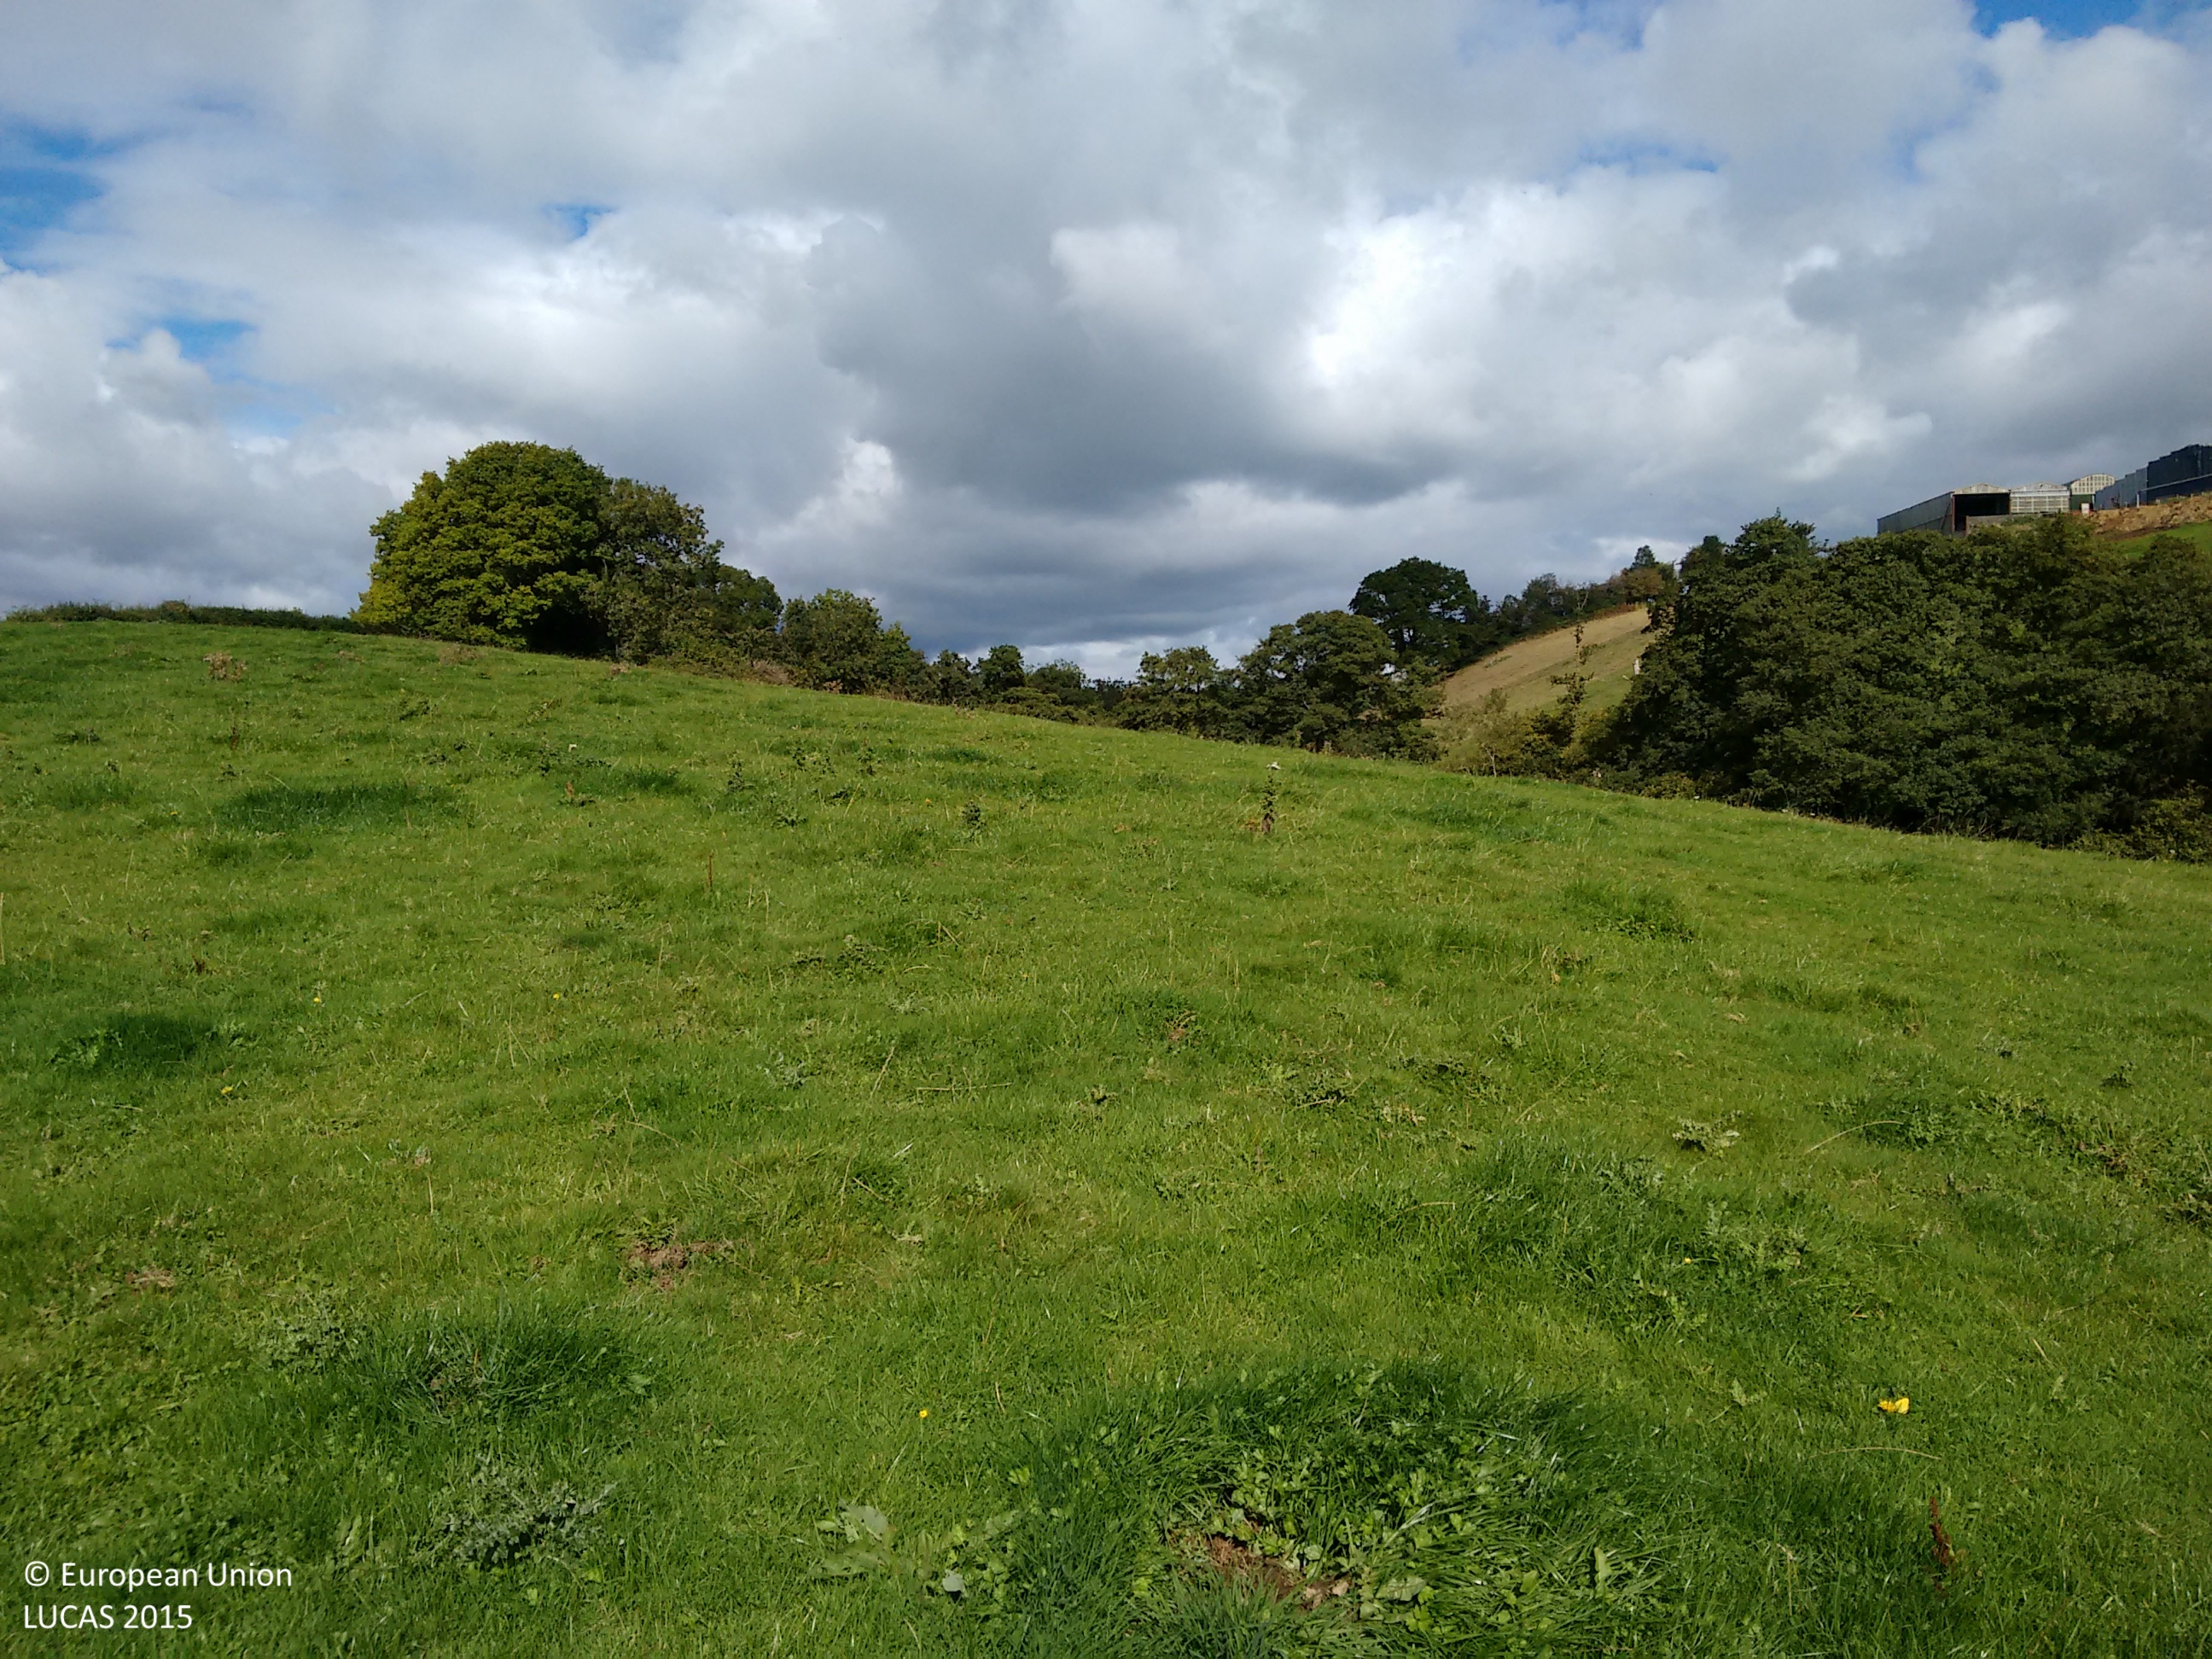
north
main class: Grassland
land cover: Grassland without tree/shrub cover
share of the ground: > 75 %
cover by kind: herbaceous plants 100 %
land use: Agriculture (excluding fallow land and kitchen gardens)
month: September
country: GB
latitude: 51.6428
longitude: -2.9793
